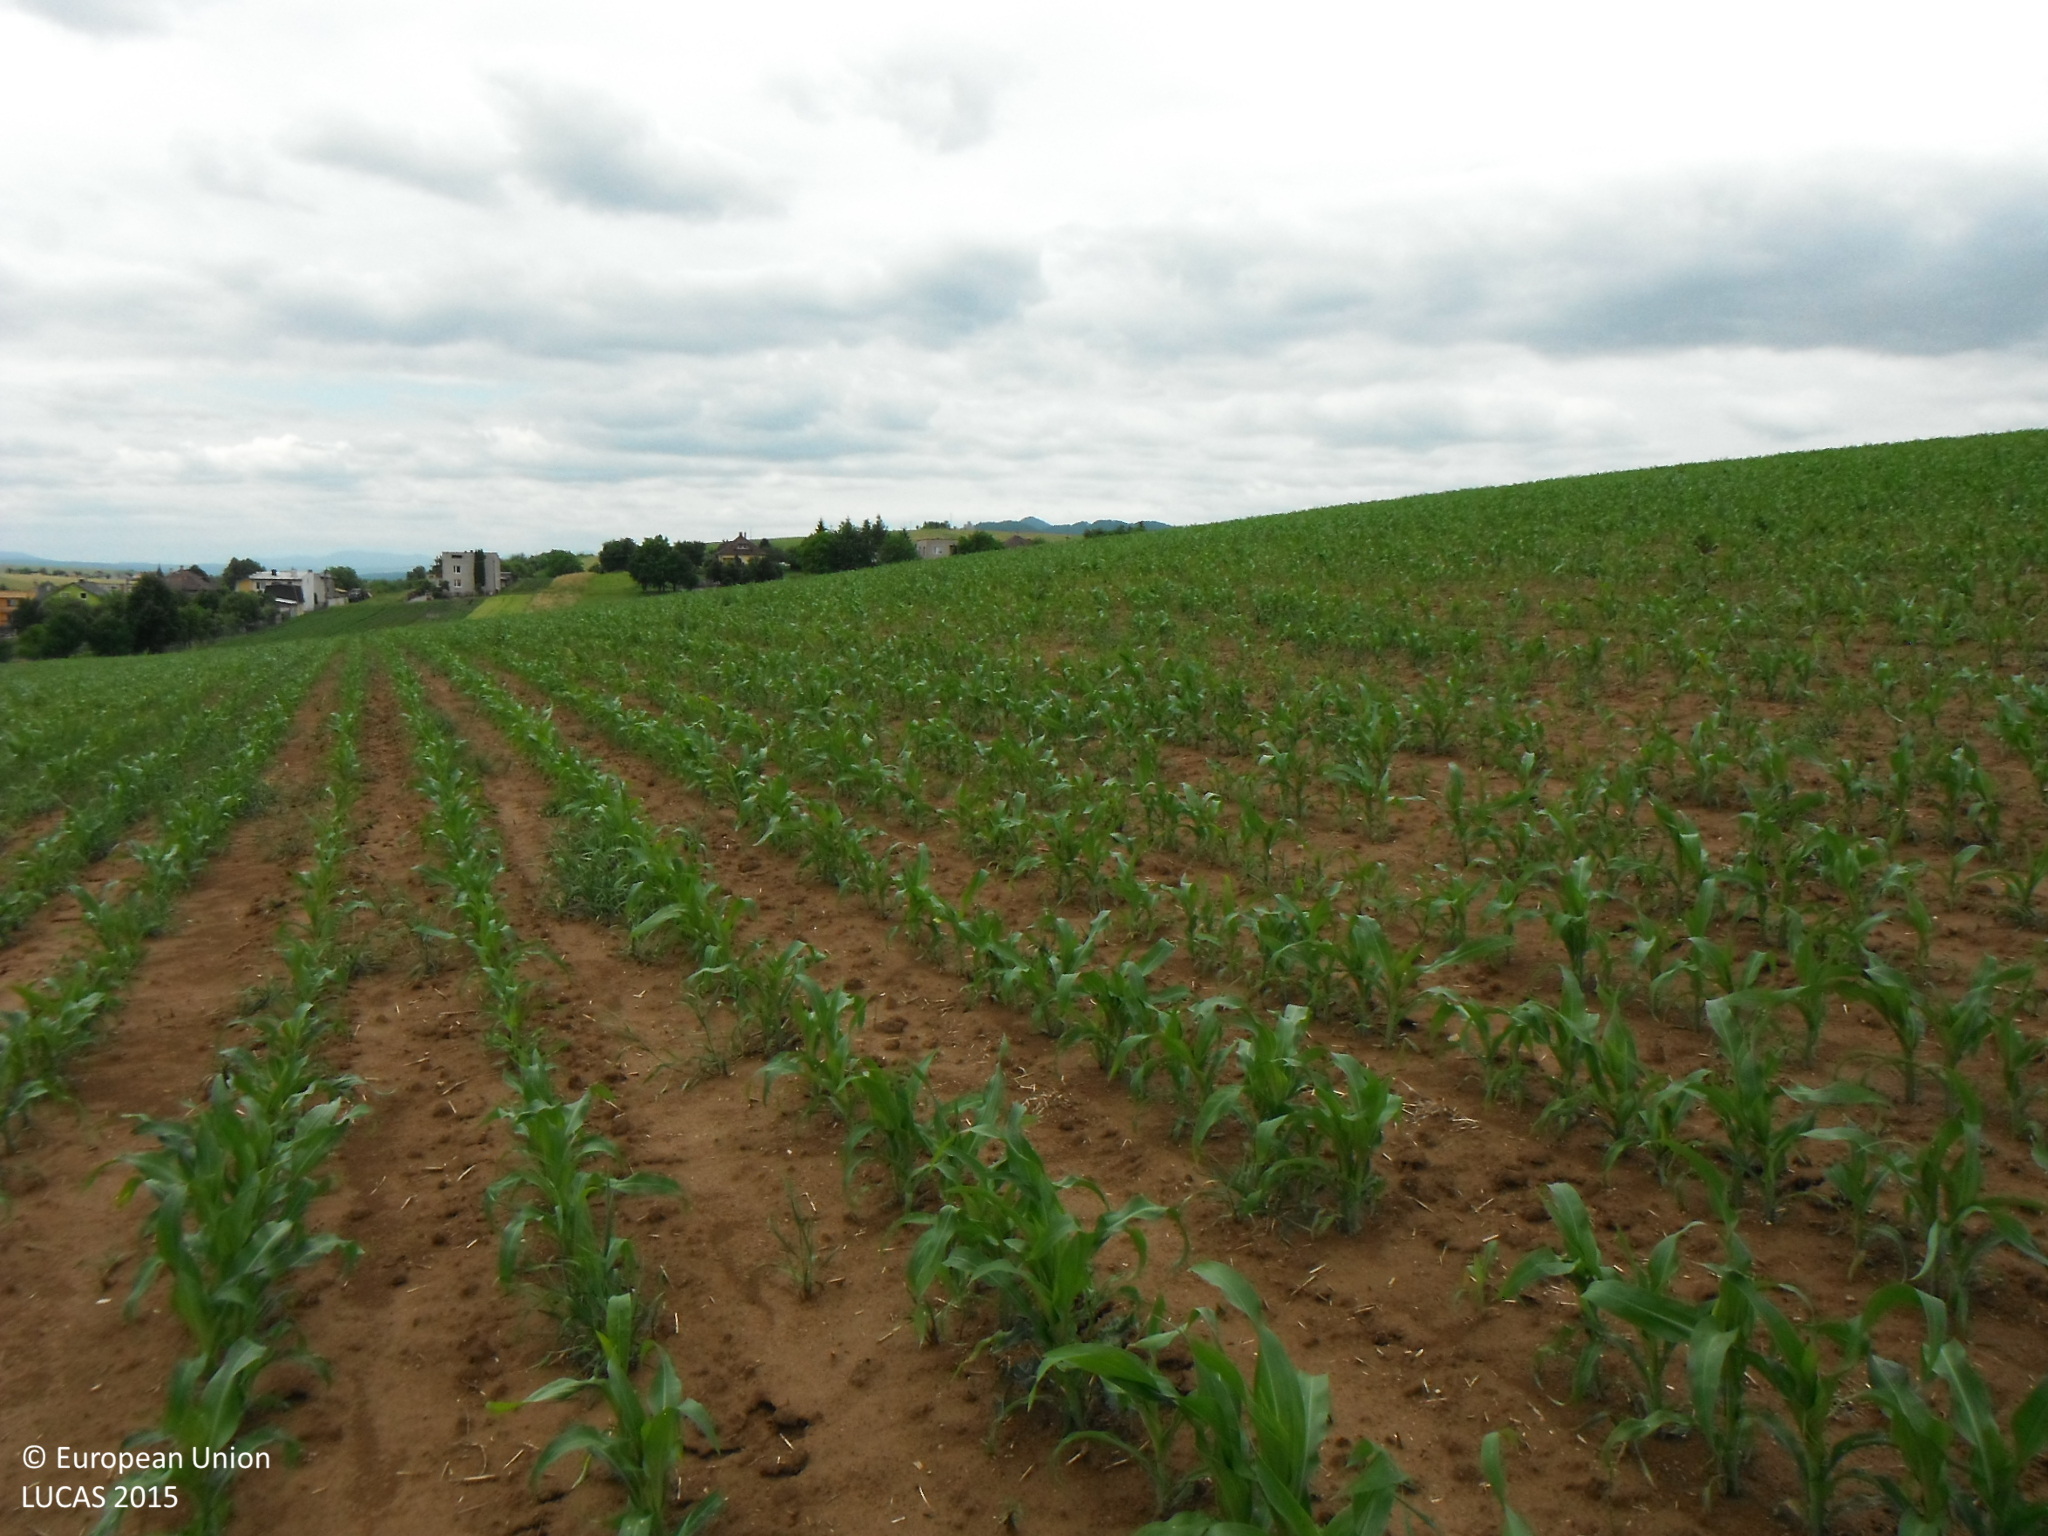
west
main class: Cropland
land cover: Maize
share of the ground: 25 - 50 %
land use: Agriculture (excluding fallow land and kitchen gardens)
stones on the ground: < 10 %
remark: Temporary flooded
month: June
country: SK
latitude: 49.0483
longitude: 21.3895
